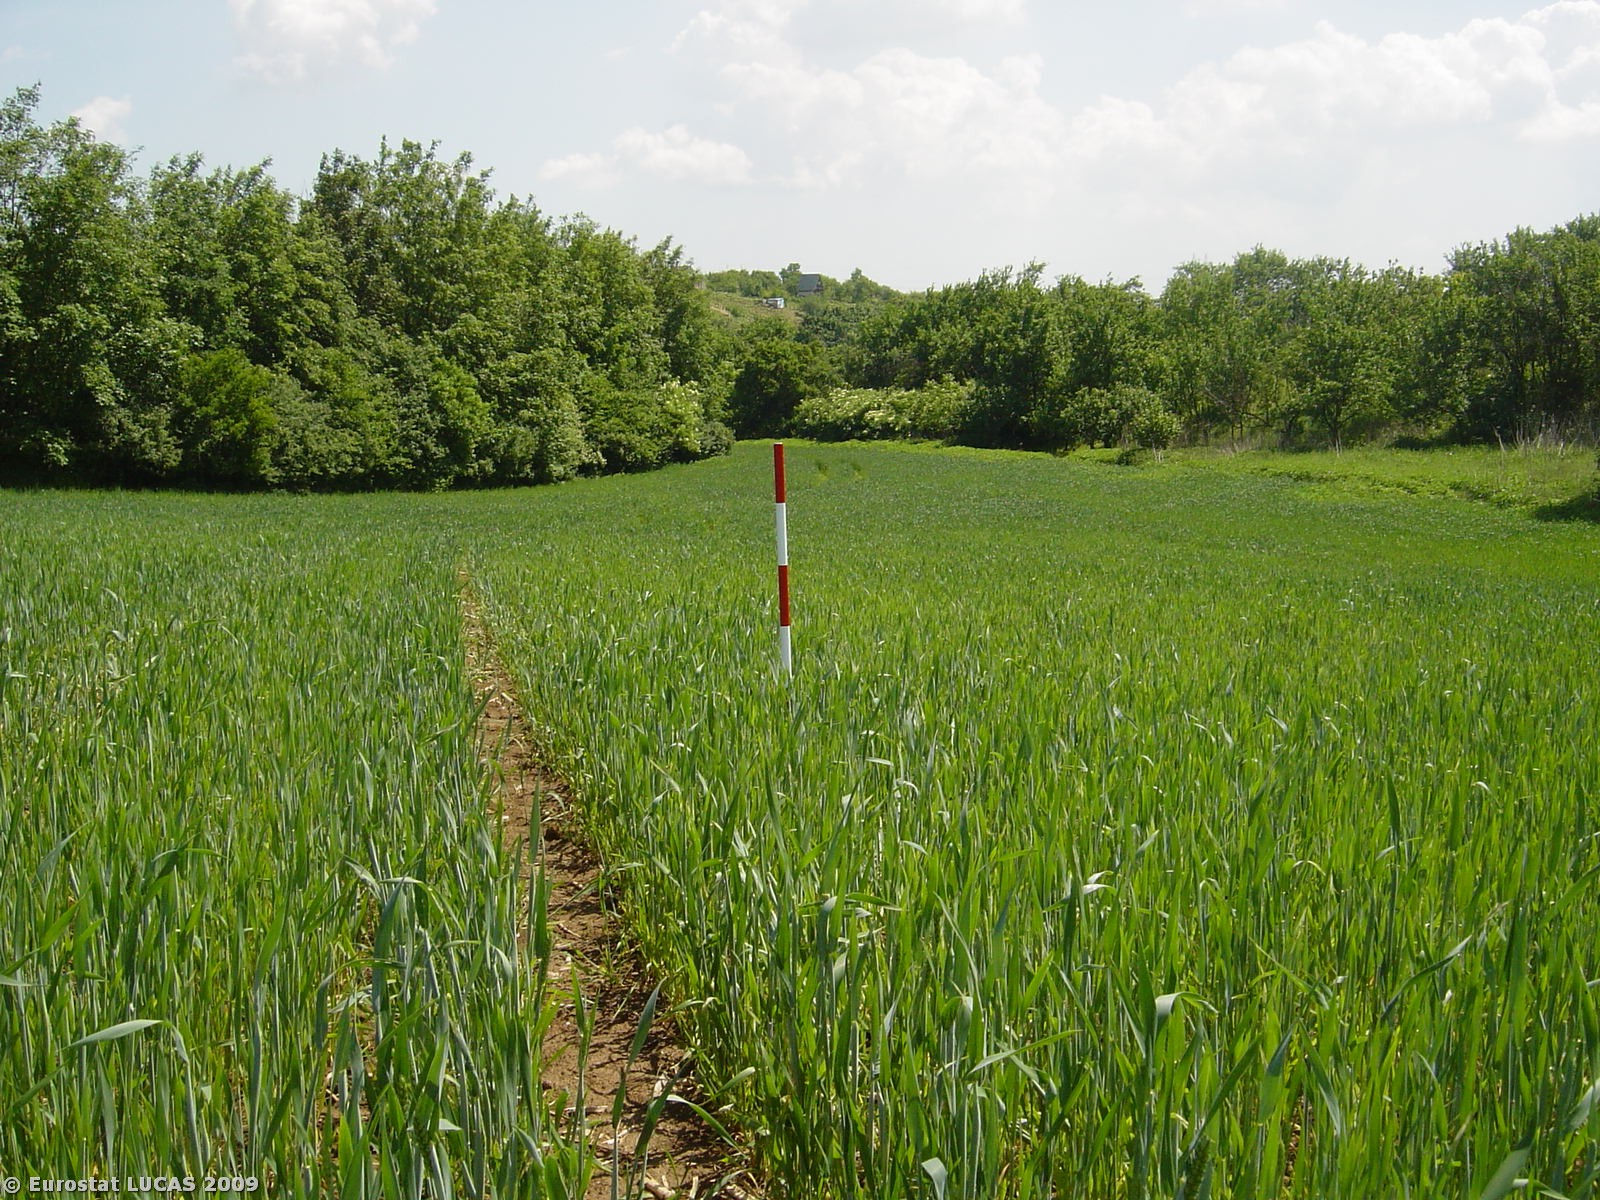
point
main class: Cropland
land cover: Common wheat
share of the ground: > 75 %
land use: Agriculture (excluding fallow land and kitchen gardens)
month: May
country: CZ
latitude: 49.0414
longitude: 17.1095
